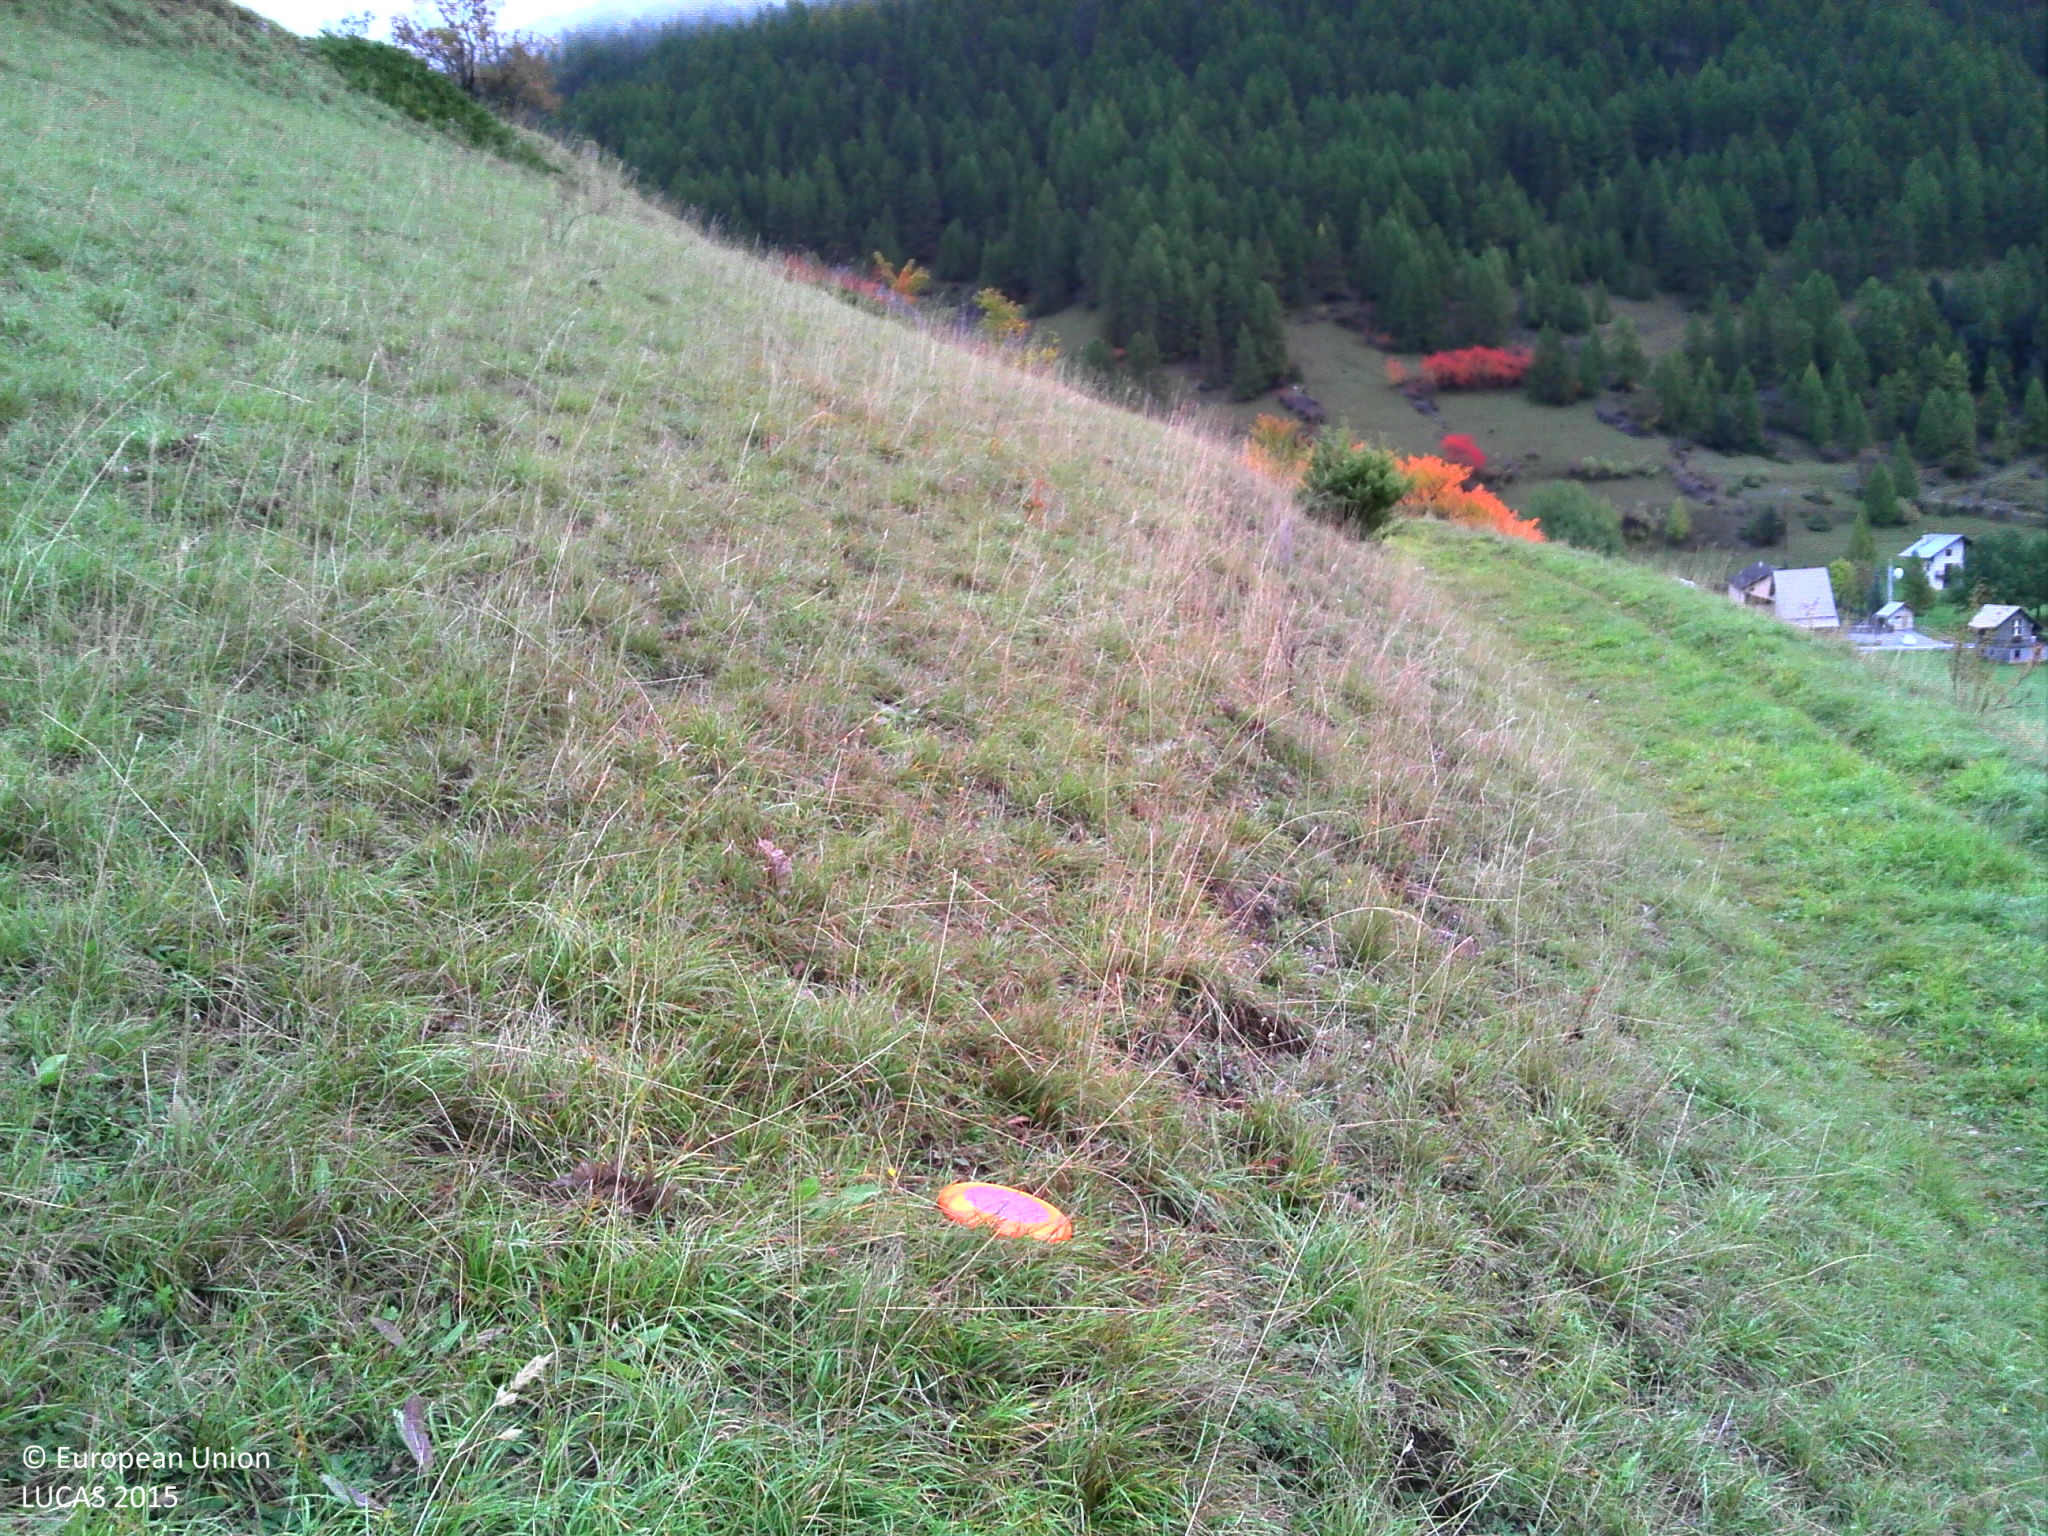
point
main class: Grassland
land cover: Grassland without tree/shrub cover
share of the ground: > 75 %
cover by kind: herbaceous plants 90 %, shrubs 5 %, consolidated bare surface 5 %
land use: Agriculture (excluding fallow land and kitchen gardens)
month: October
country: FR
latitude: 44.7684
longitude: 6.7332
